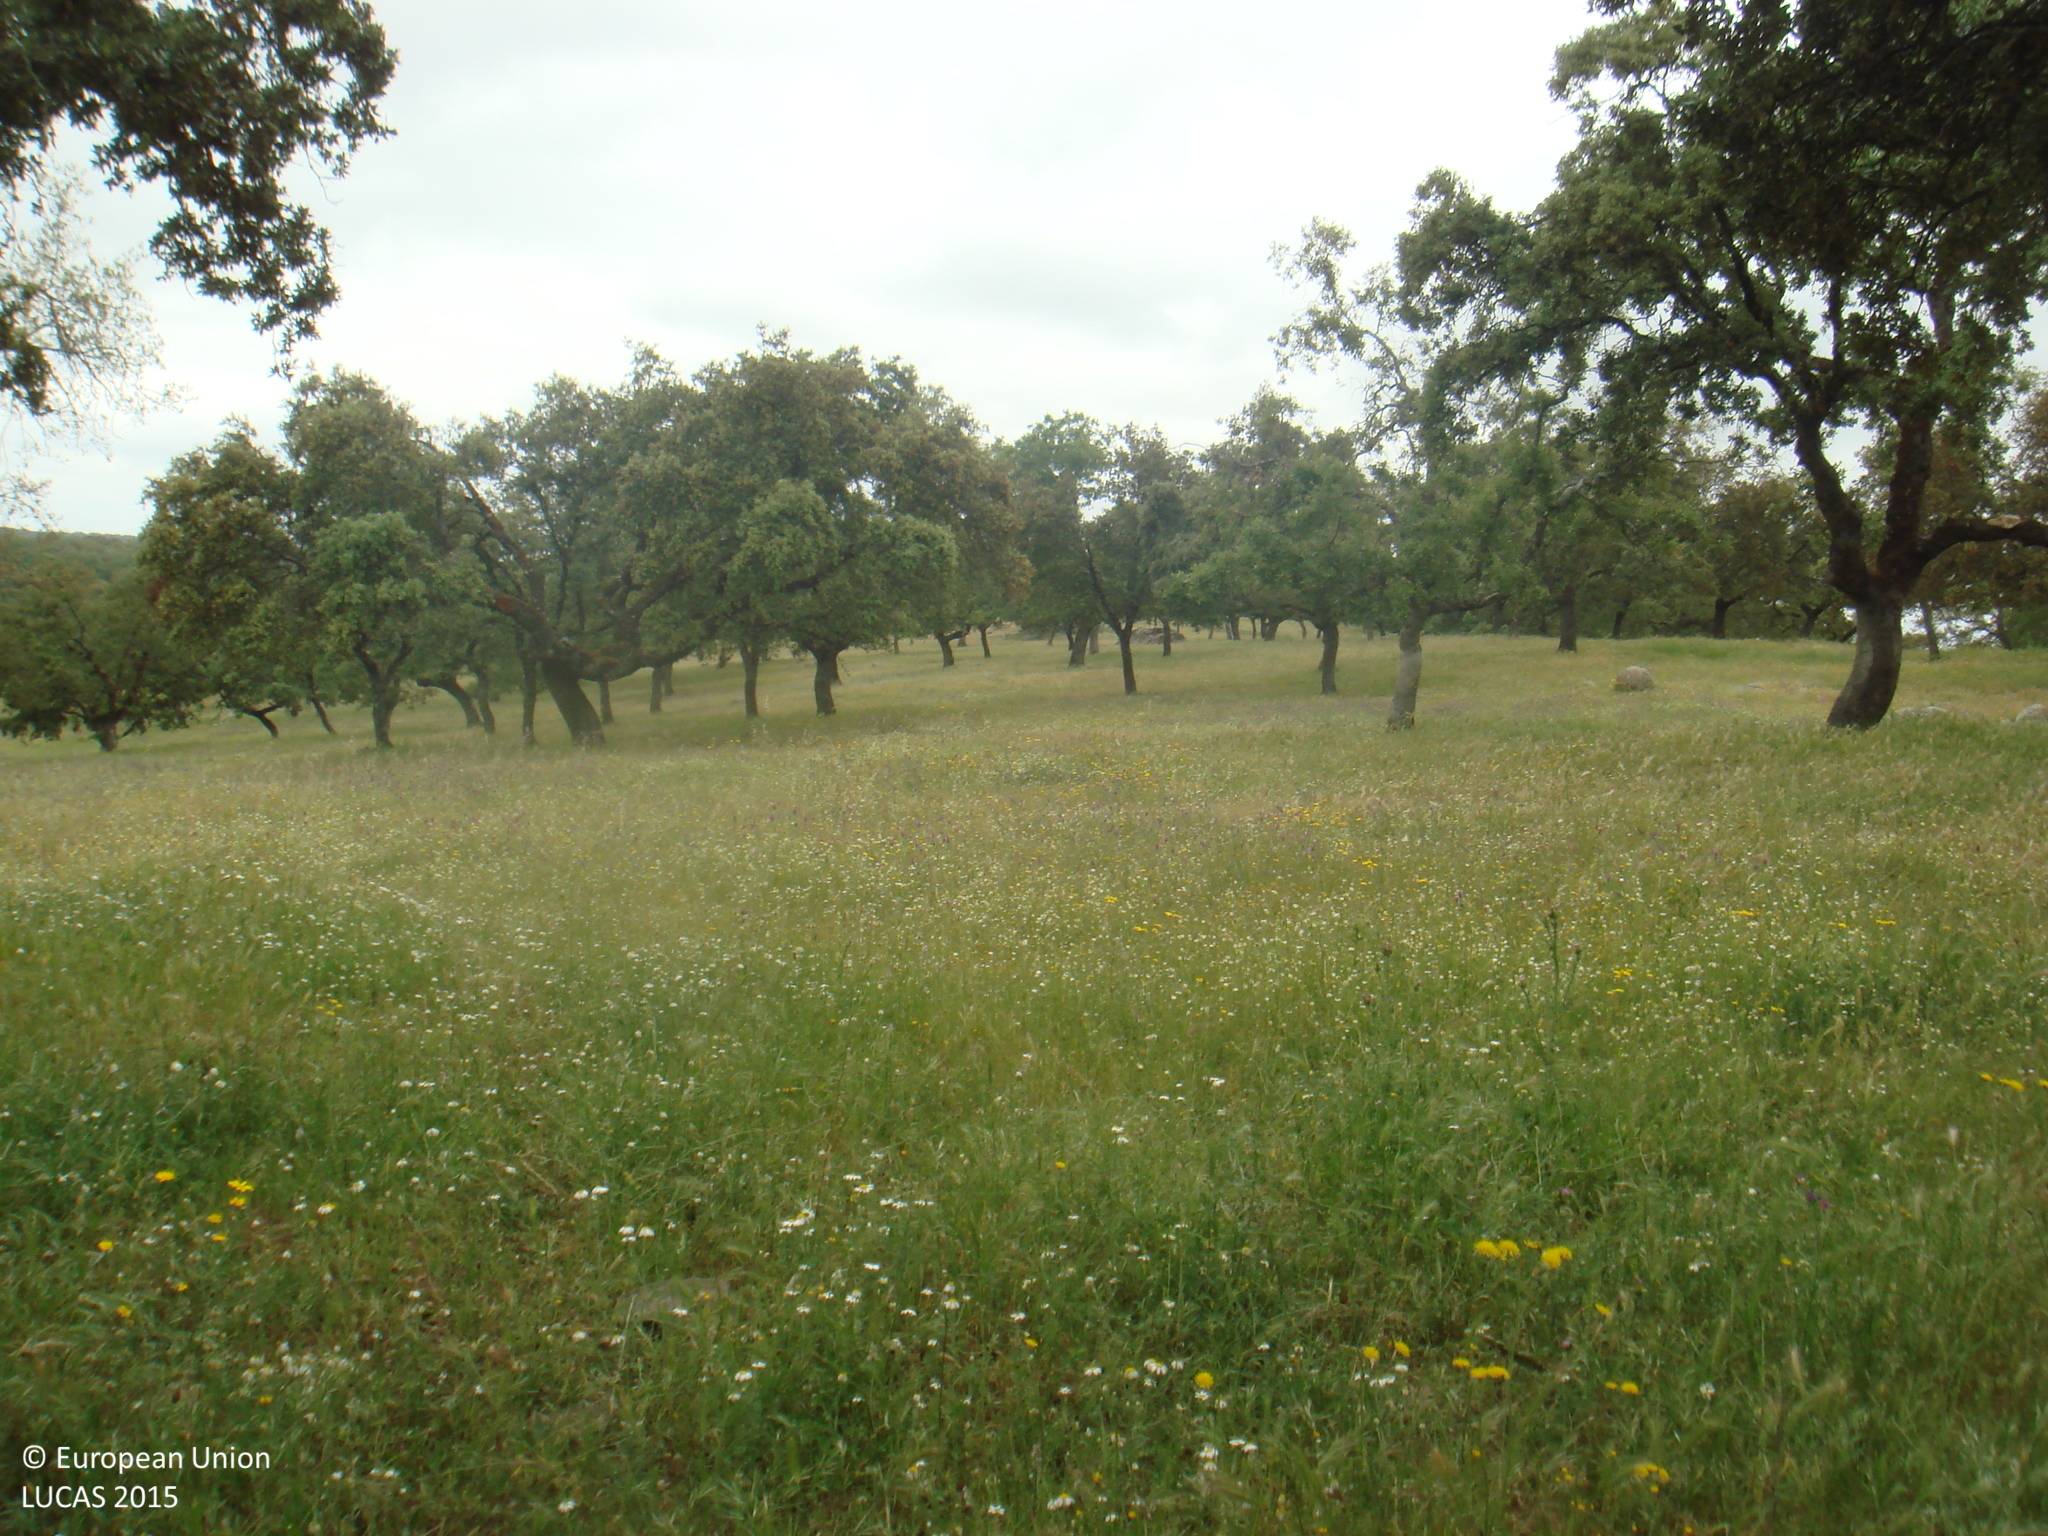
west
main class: Woodland
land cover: Broadleaved woodland
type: broadleaved evergreen forest
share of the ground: 25 - 50 %
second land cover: Grassland without tree/shrub cover
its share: 50 - 75 %
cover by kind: herbaceous plants 60 %, broadleaved forest trees 40 %
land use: Forestry
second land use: Agriculture (excluding fallow land and kitchen gardens)
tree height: > 5 m
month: May
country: ES
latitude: 38.2442
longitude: -4.4006
